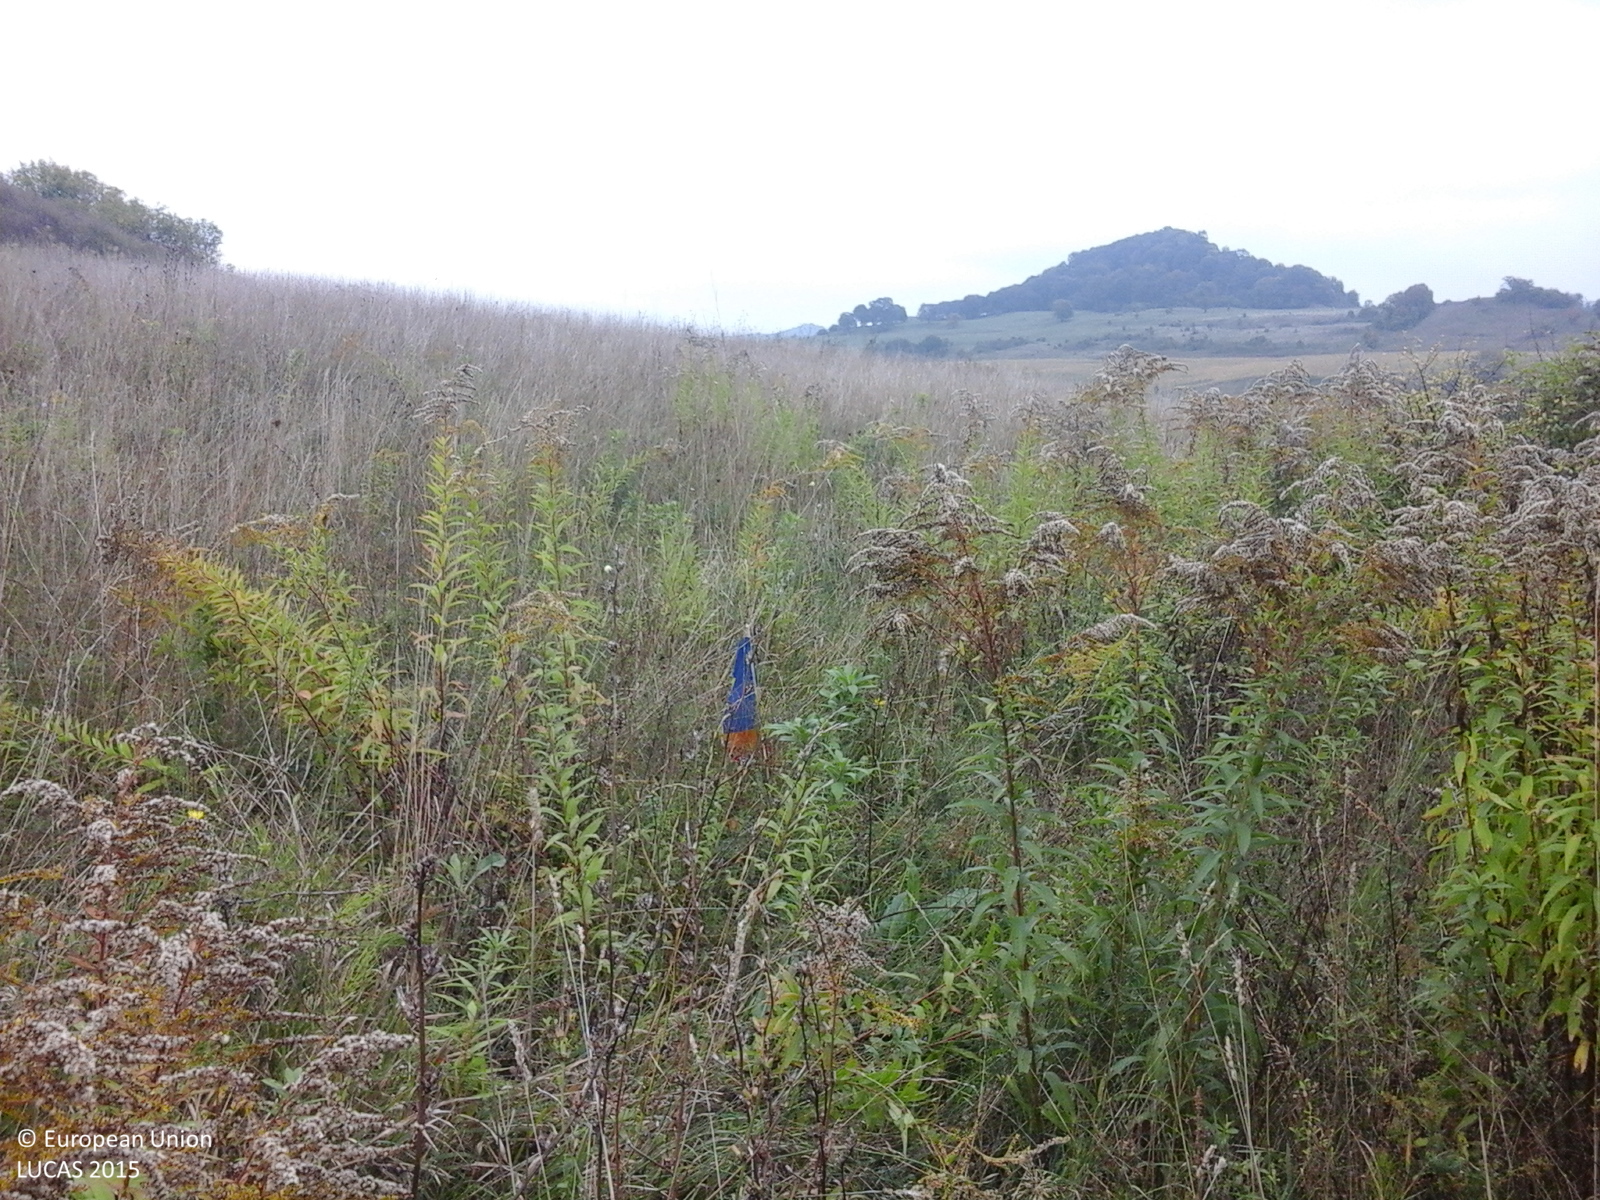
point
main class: Grassland
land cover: Grassland with sparse tree/shrub cover
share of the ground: > 75 %
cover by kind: herbaceous plants 85 %, shrubs 10 %, broadleaved forest trees 5 %
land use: Agriculture (excluding fallow land and kitchen gardens)
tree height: < 5 m
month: October
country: RO
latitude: 46.2639
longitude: 24.6850
